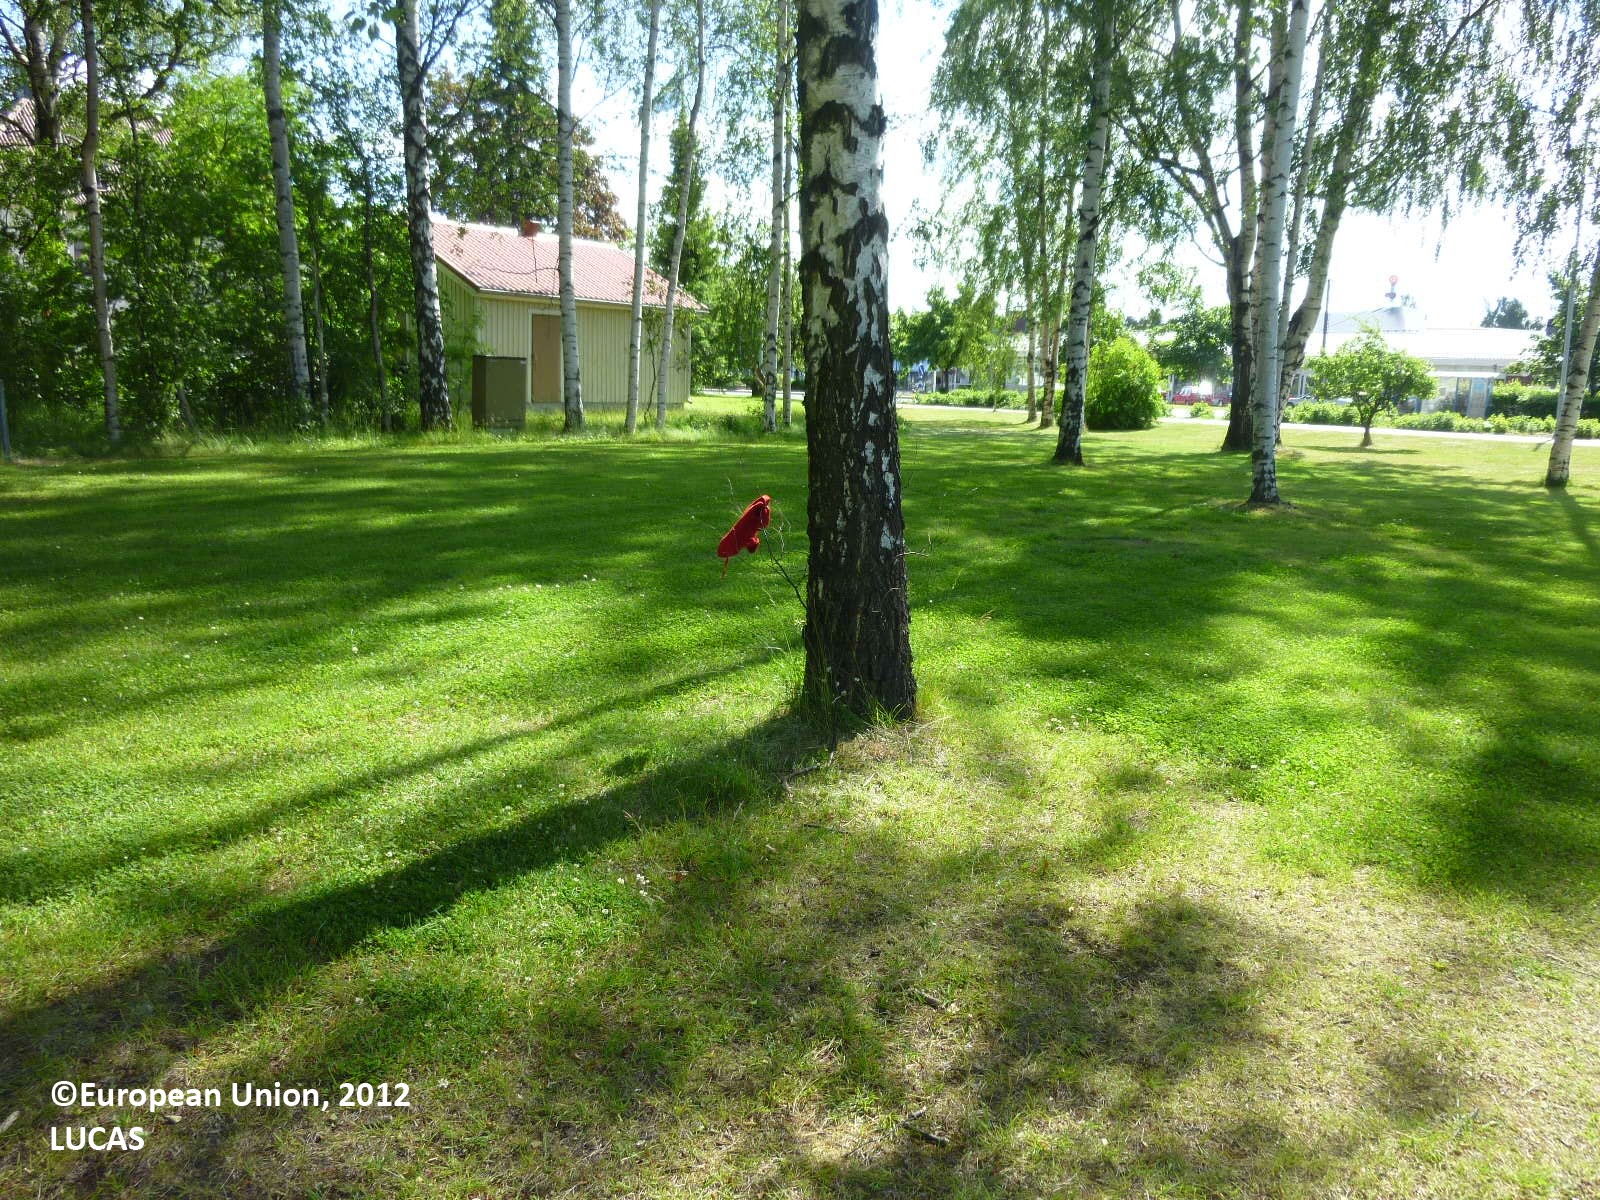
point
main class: Woodland
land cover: Broadleaved woodland
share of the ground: 50 - 75 %
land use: Amenities, museums, leisure
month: July
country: FI
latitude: 61.3149
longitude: 22.1431
